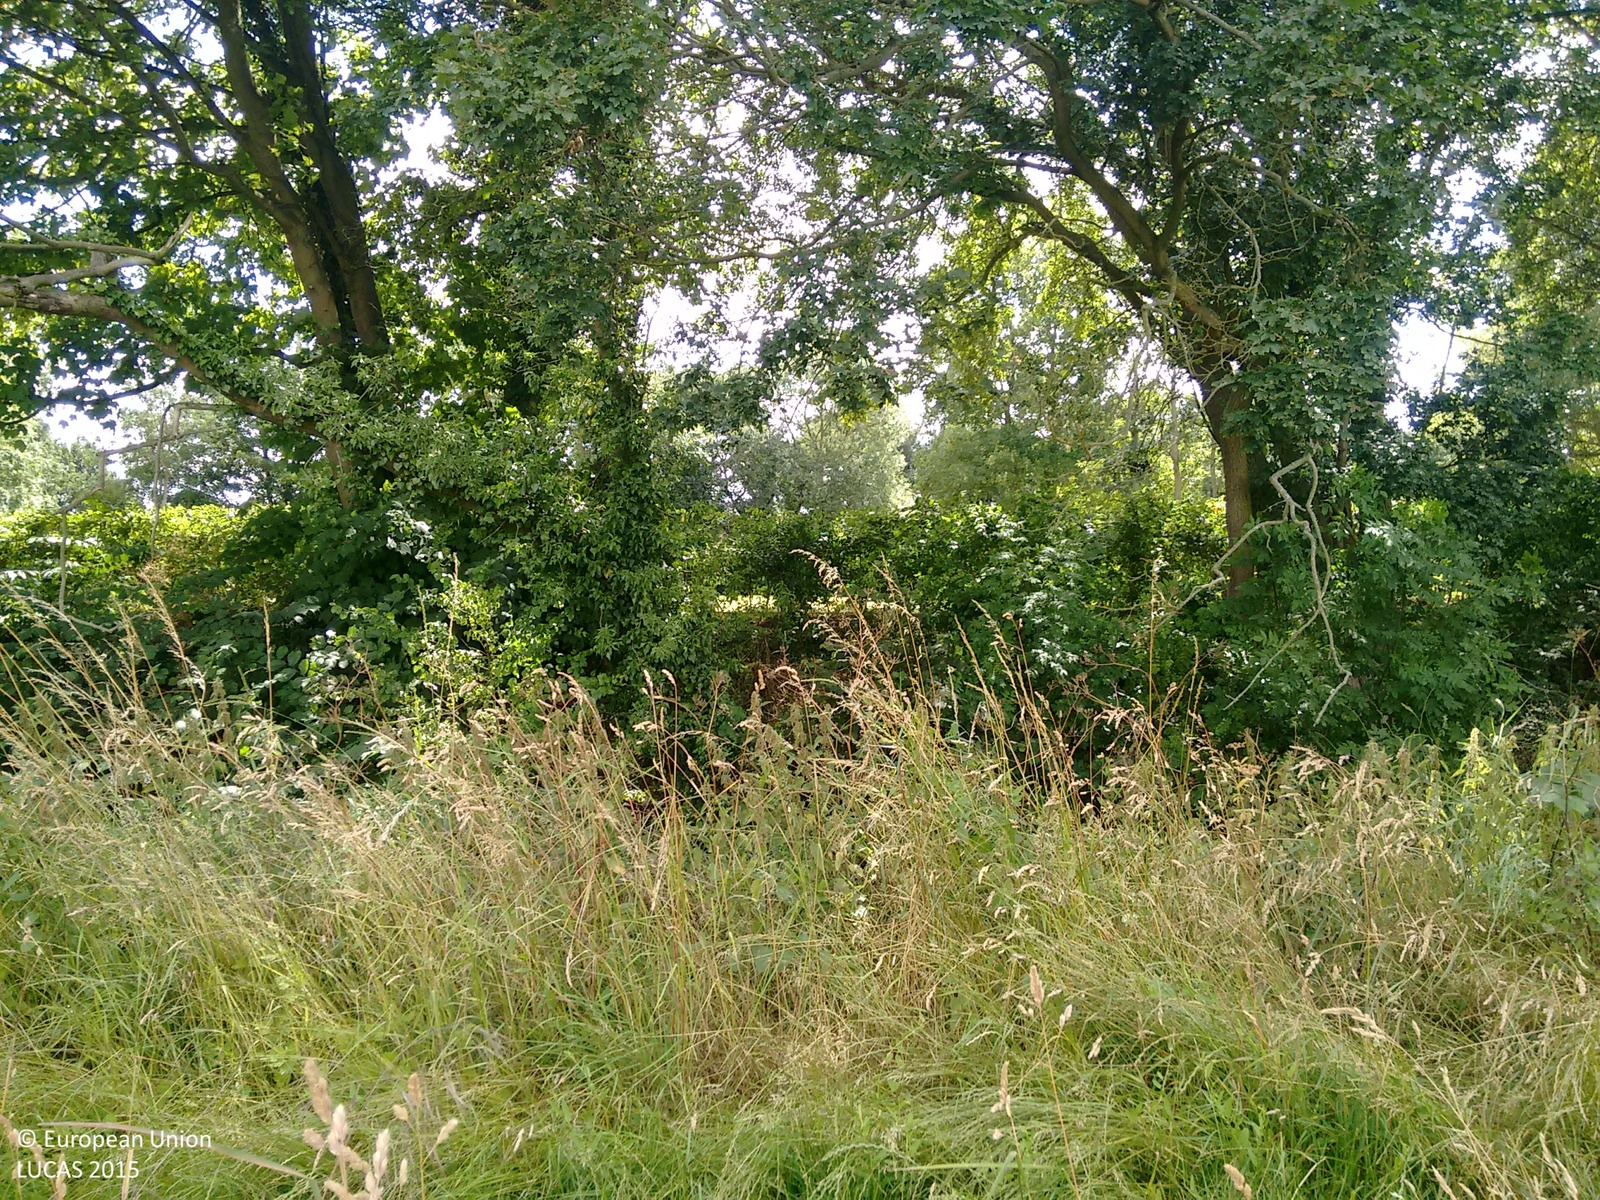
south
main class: Cropland
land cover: Dry pulses
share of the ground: > 75 %
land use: Agriculture (excluding fallow land and kitchen gardens)
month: July
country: GB
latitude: 51.8076
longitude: 0.4135
